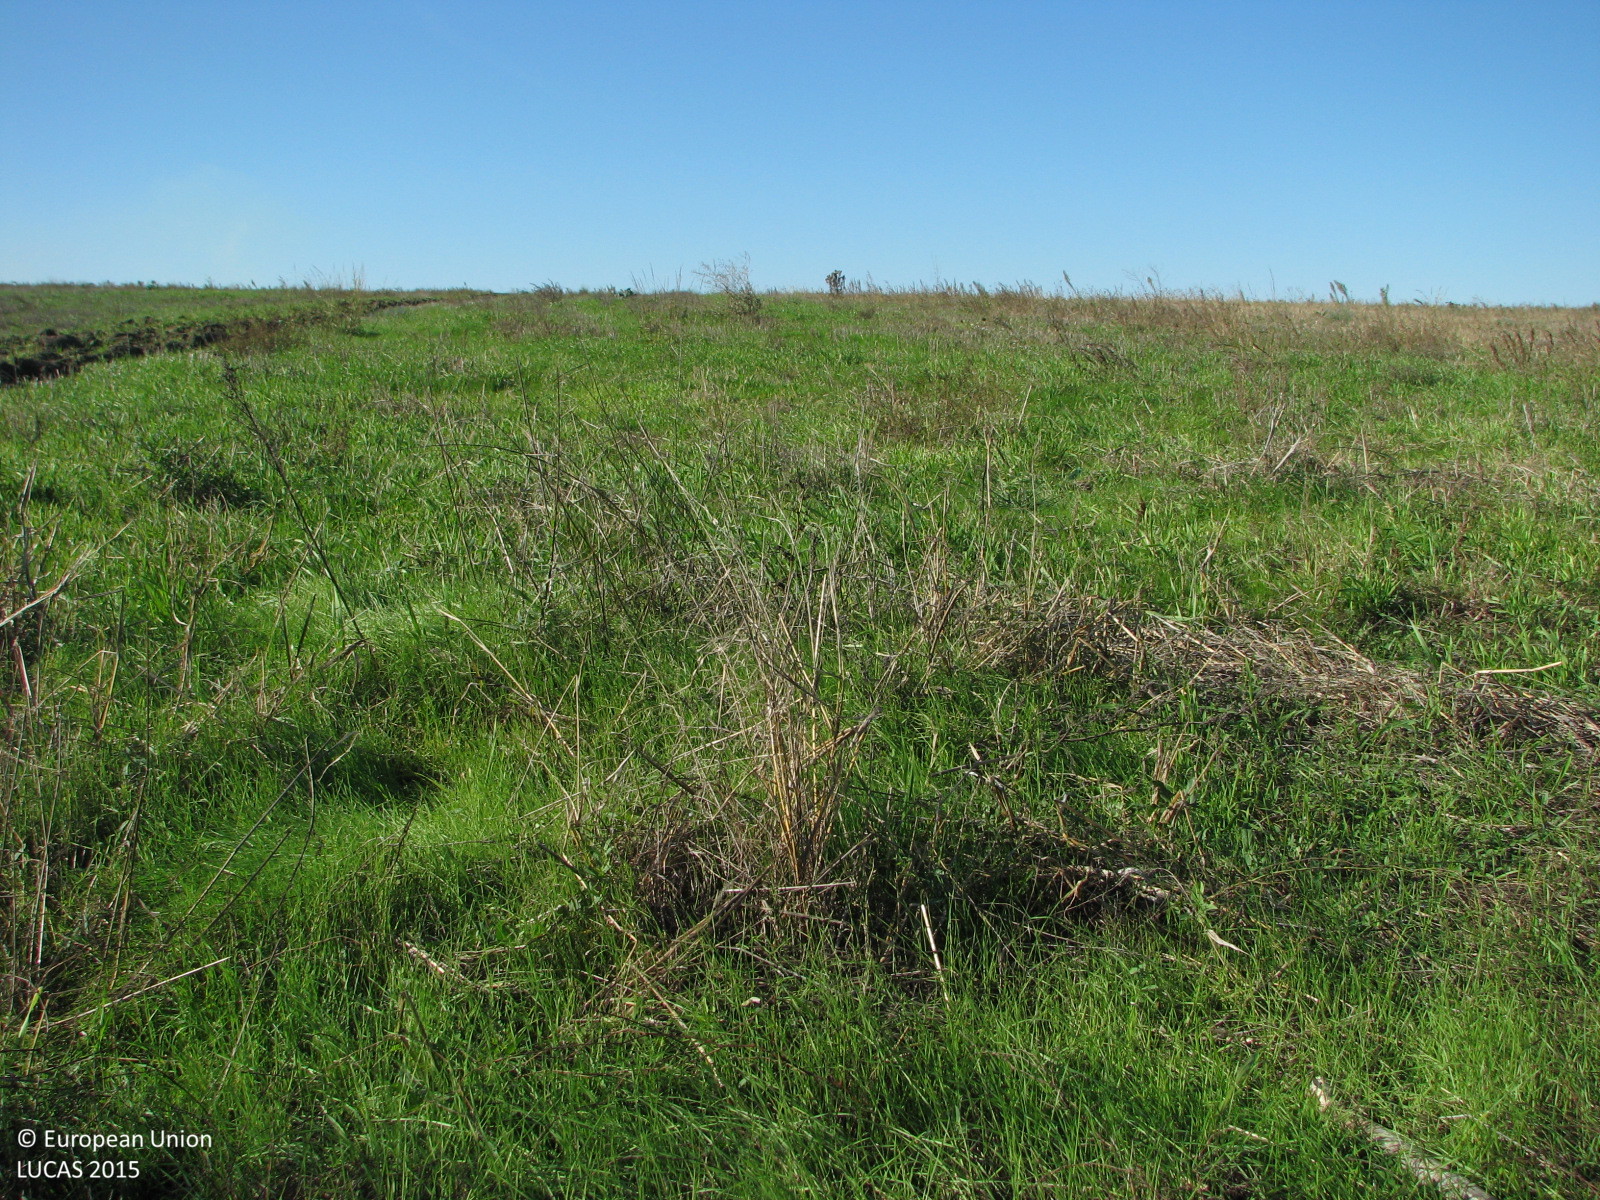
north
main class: Shrubland
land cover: Shrubland with sparse tree cover
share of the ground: 50 - 75 %
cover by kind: shrubs 70 %, herbaceous plants 25 %, broadleaved forest trees 5 %
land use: Semi-natural and natural areas not in use
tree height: < 5 m
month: October
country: BG
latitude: 42.1918
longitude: 26.2731
